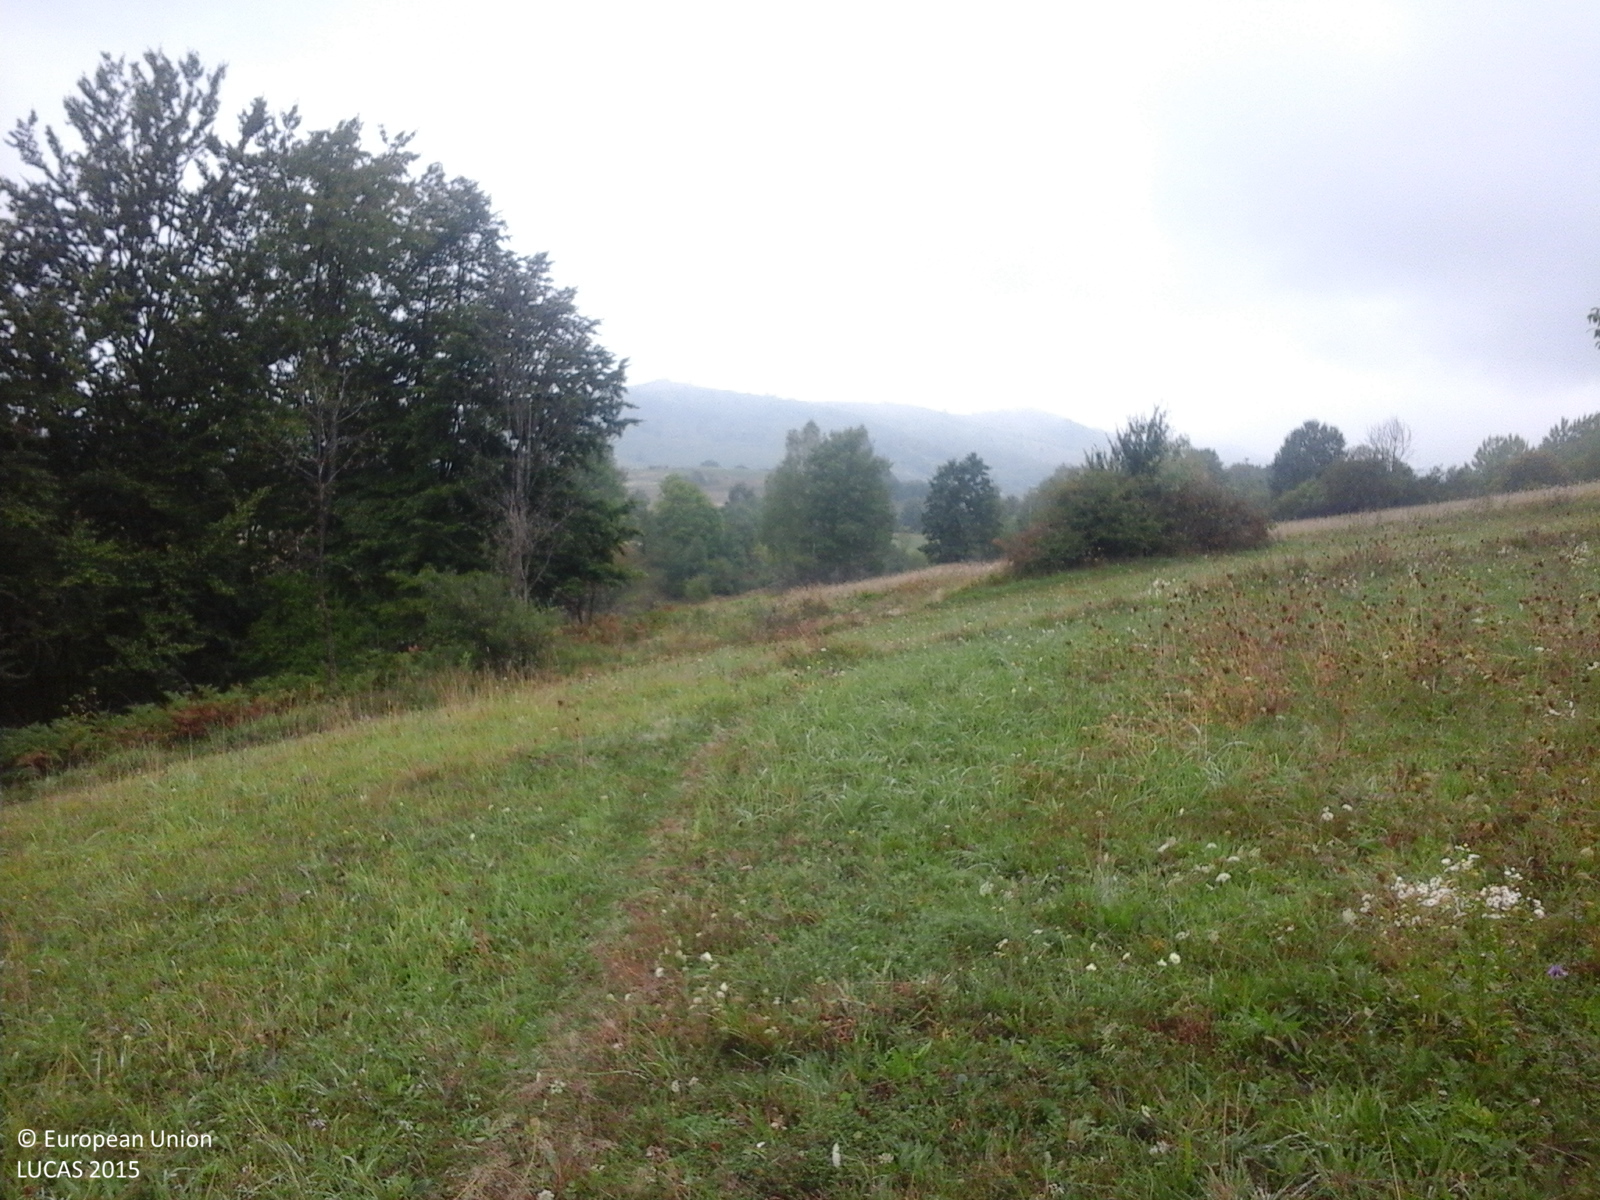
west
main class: Grassland
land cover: Grassland without tree/shrub cover
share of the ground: > 75 %
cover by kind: herbaceous plants 100 %
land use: Agriculture (excluding fallow land and kitchen gardens)
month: September
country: RO
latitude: 46.9124
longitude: 22.4608
